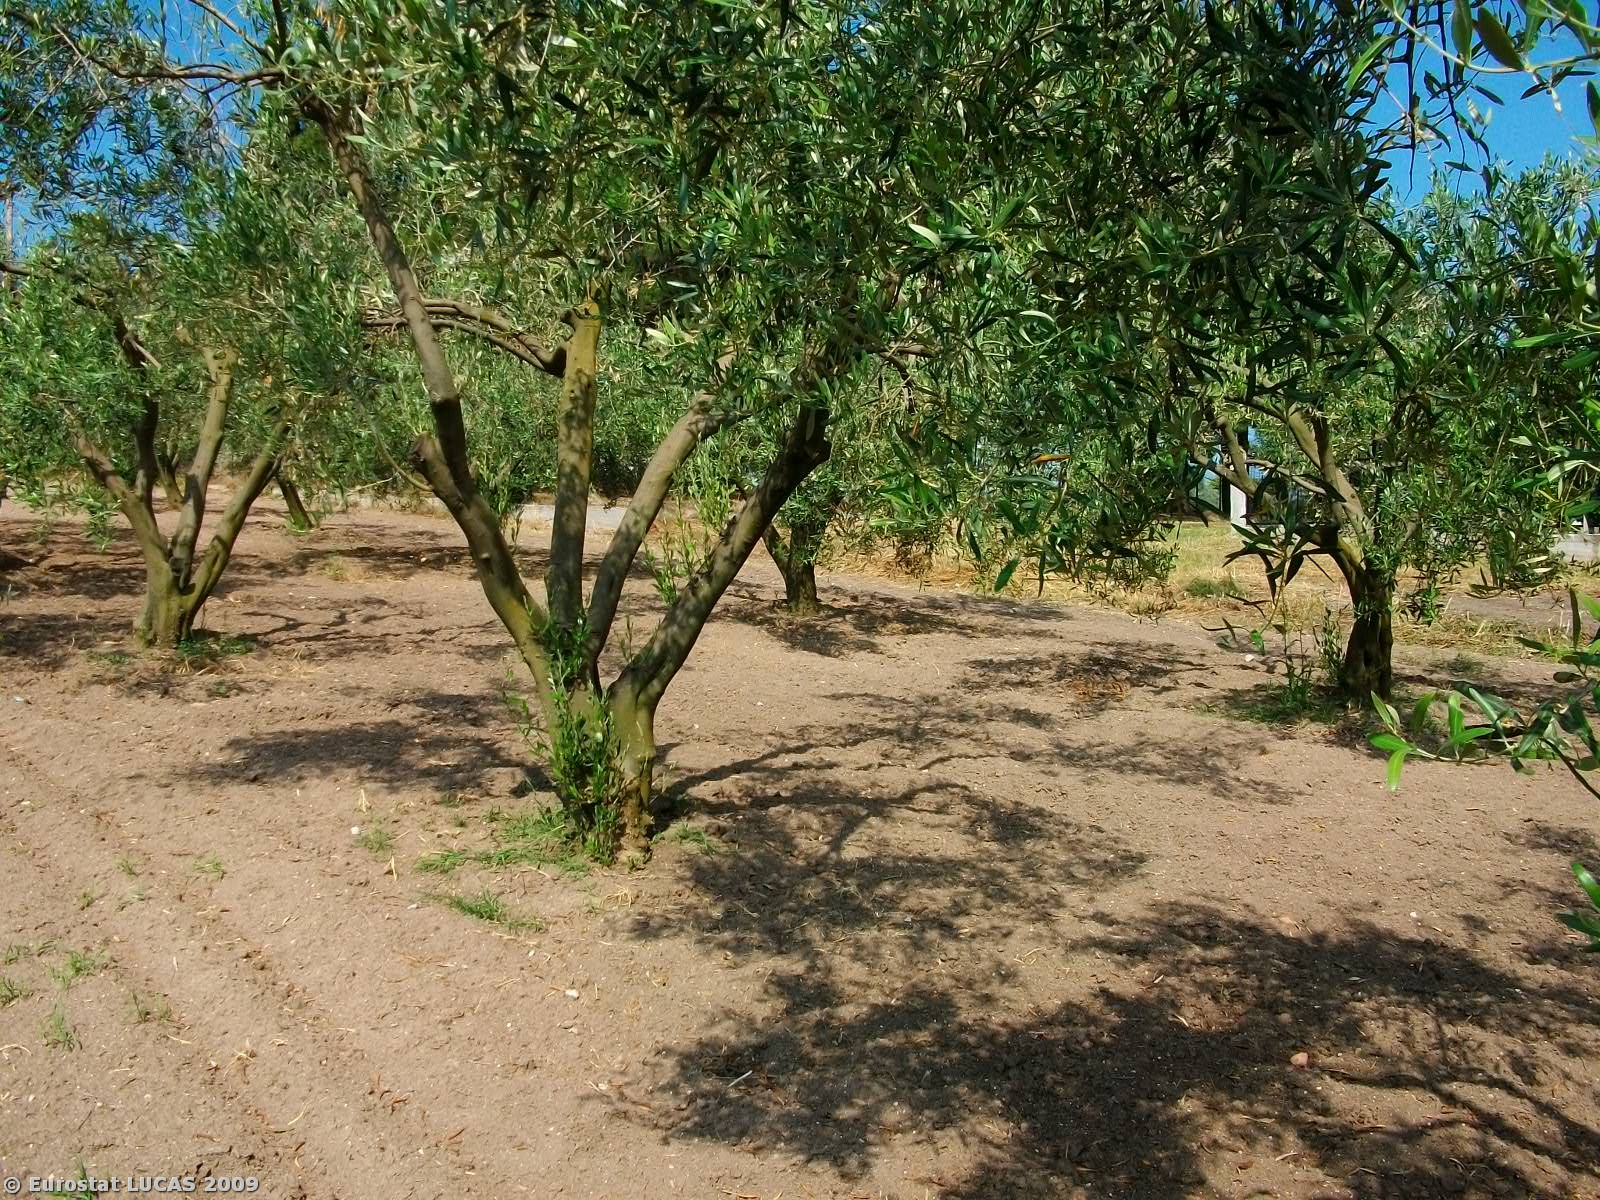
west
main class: Cropland
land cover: Olive groves
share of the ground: 50 - 75 %
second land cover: Bare land
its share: > 75 %
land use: Agriculture (excluding fallow land and kitchen gardens)
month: May
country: GR
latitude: 40.3671
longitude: 22.5893
